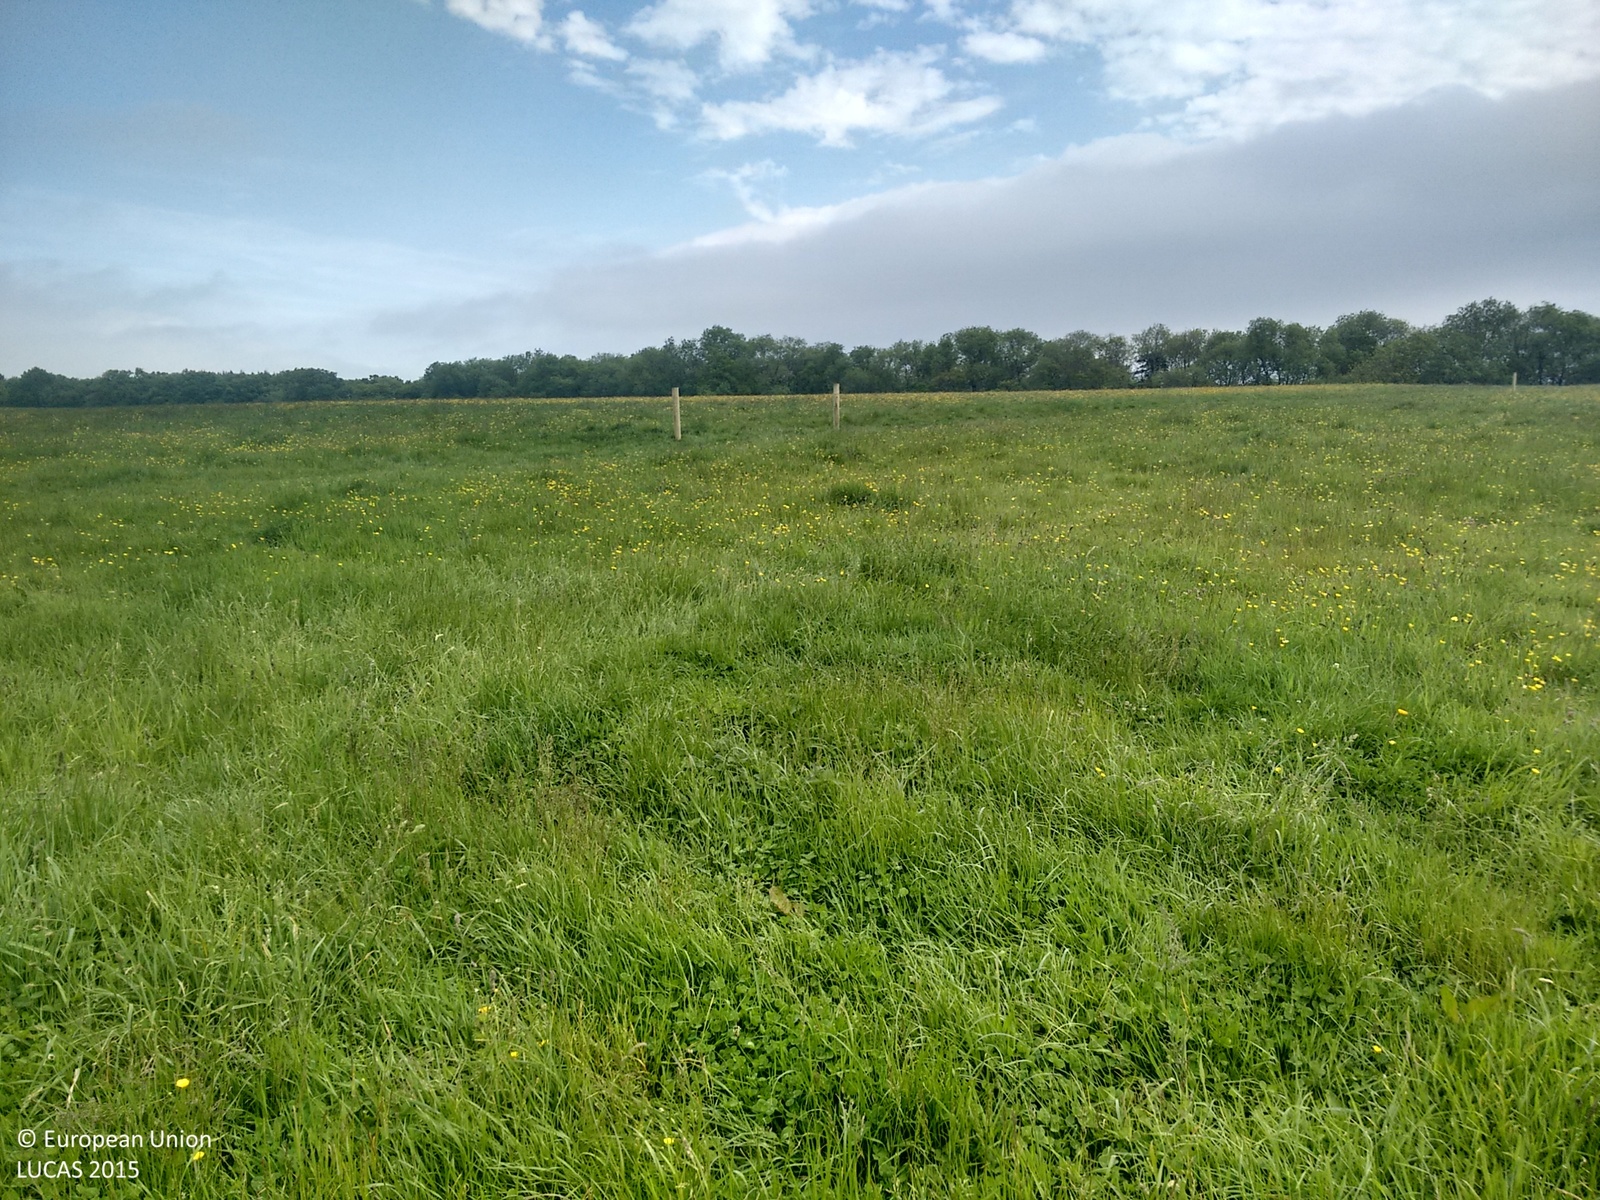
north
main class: Grassland
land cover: Grassland without tree/shrub cover
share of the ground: > 75 %
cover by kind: herbaceous plants 100 %
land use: Agriculture (excluding fallow land and kitchen gardens)
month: June
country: GB
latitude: 50.8443
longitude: -2.2908
